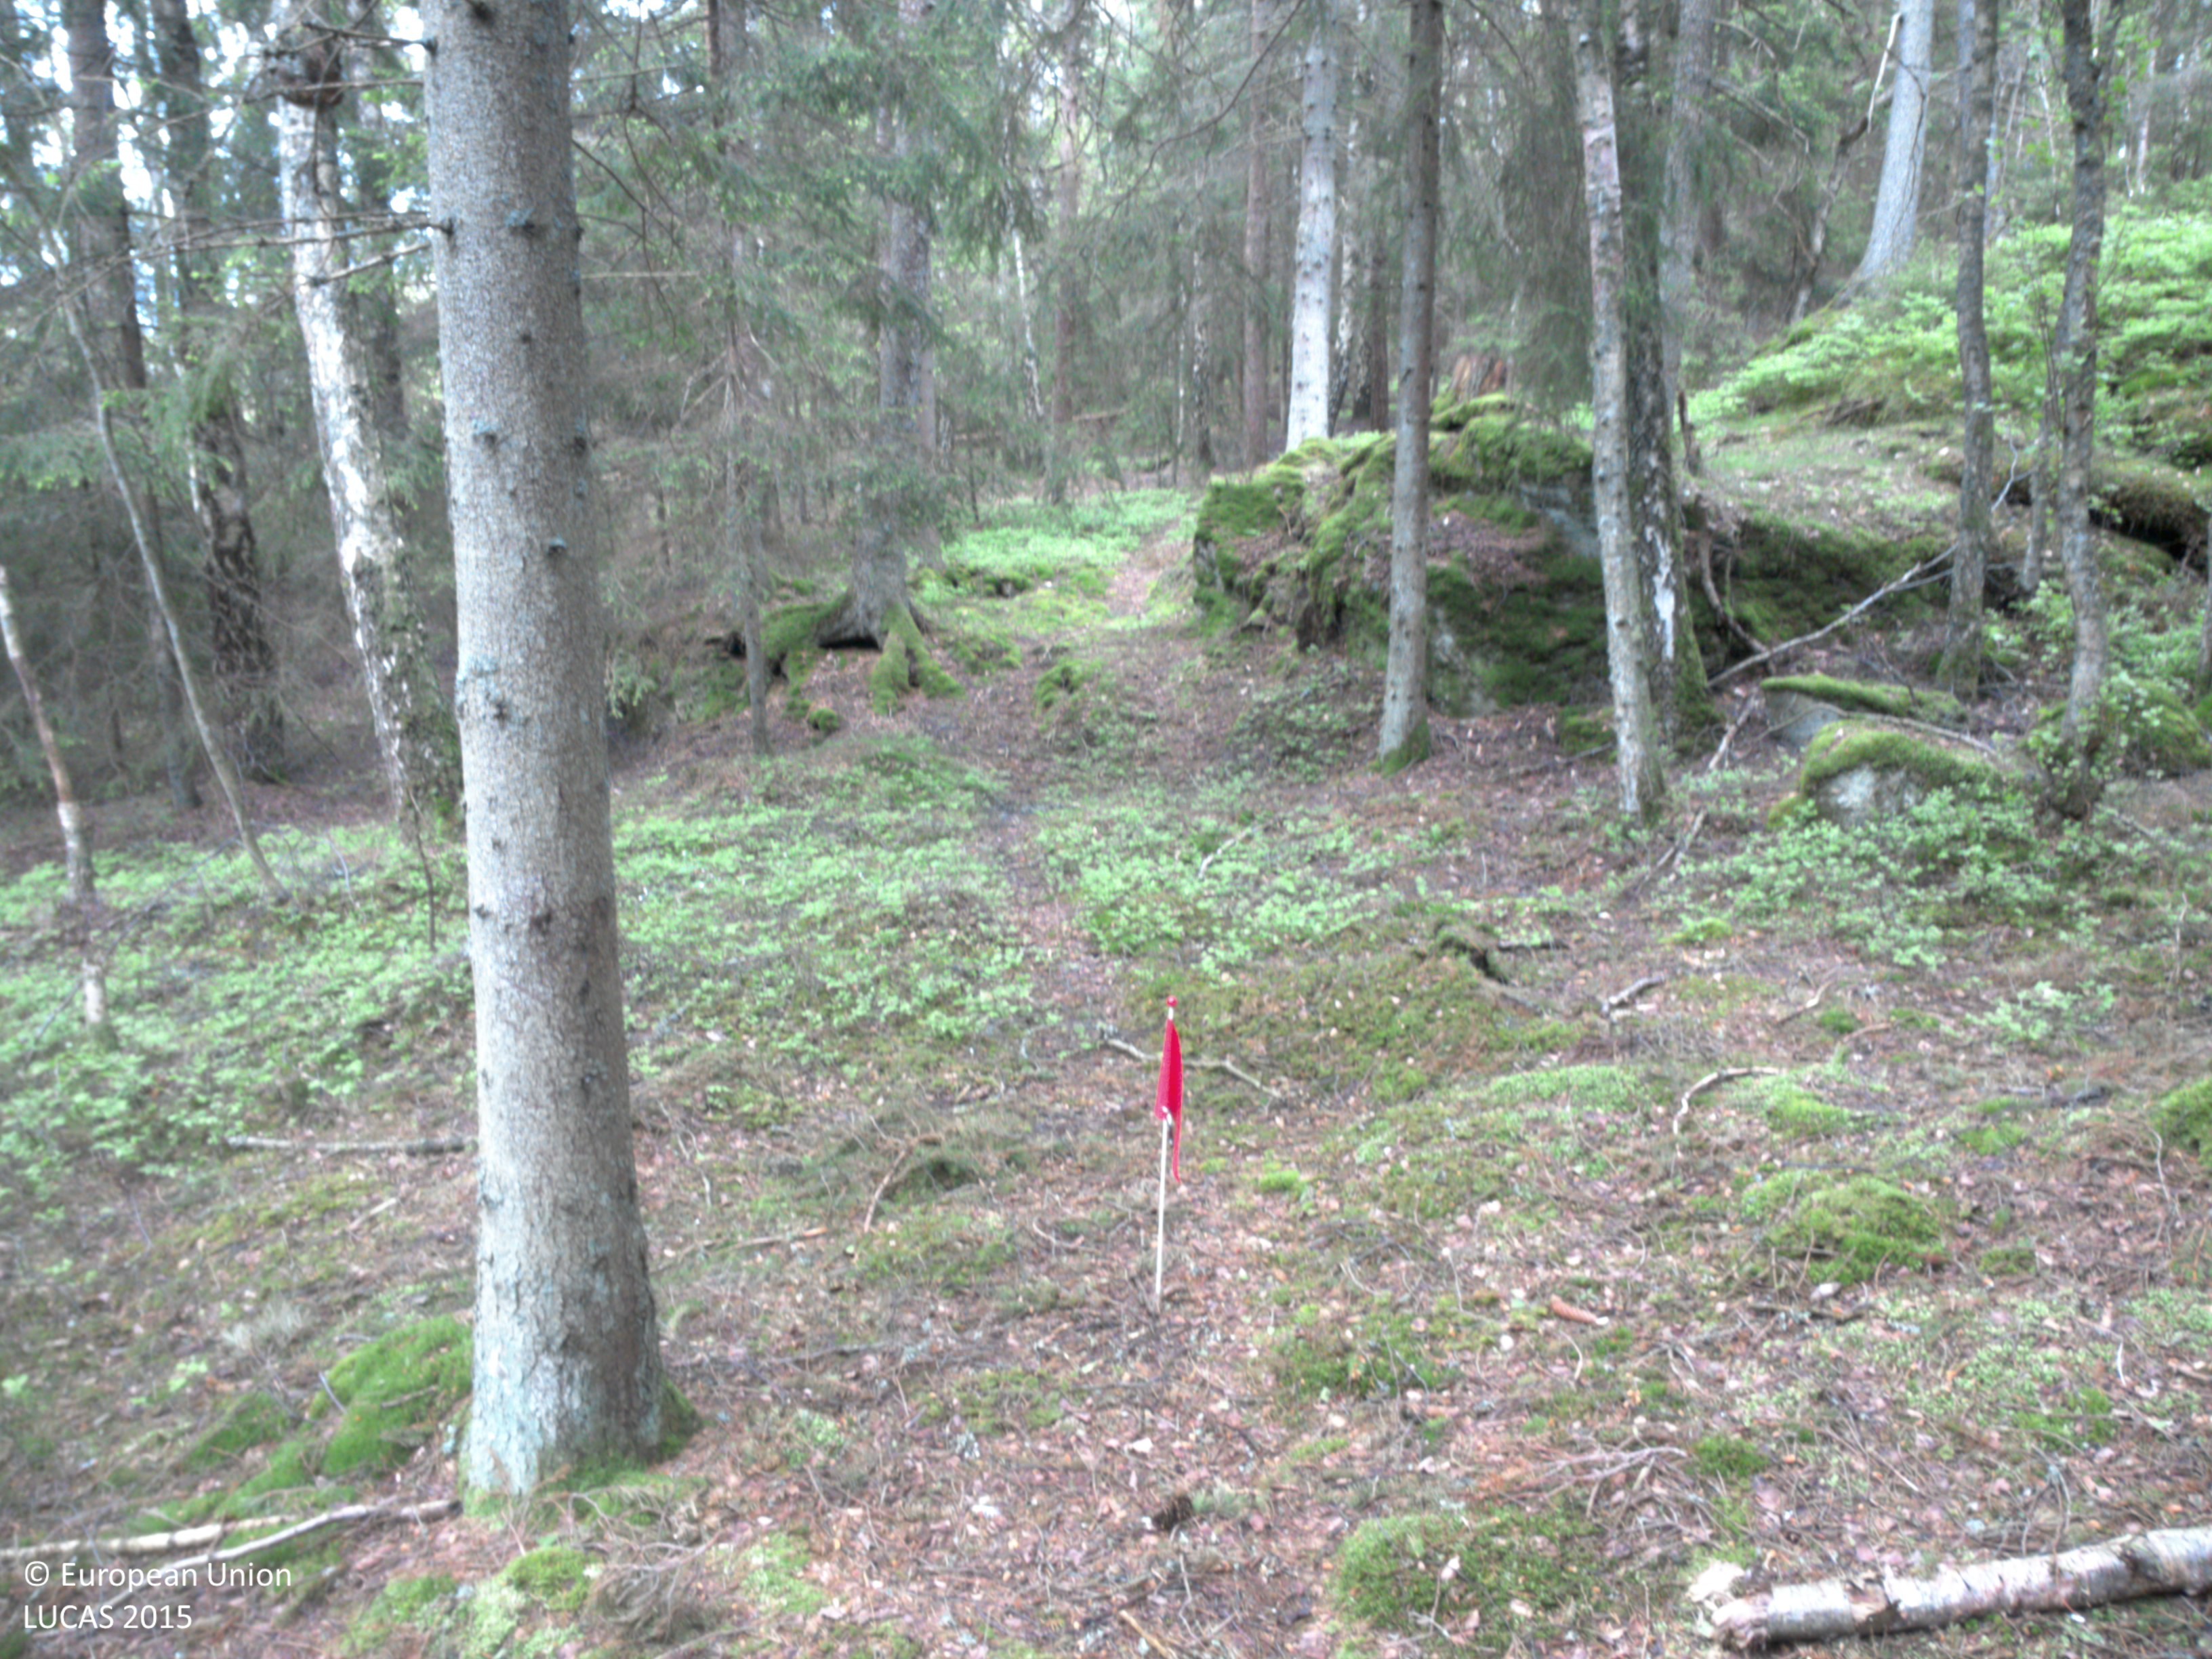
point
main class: Woodland
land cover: Spruce dominated coniferous woodland
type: boreal forest
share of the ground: 50 - 75 %
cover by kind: coniferous forest trees 65 %, herbaceous plants 30 %, broadleaved forest trees 5 %
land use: Forestry
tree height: > 5 m
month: May
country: SE
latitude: 58.2629
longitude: 11.6840
